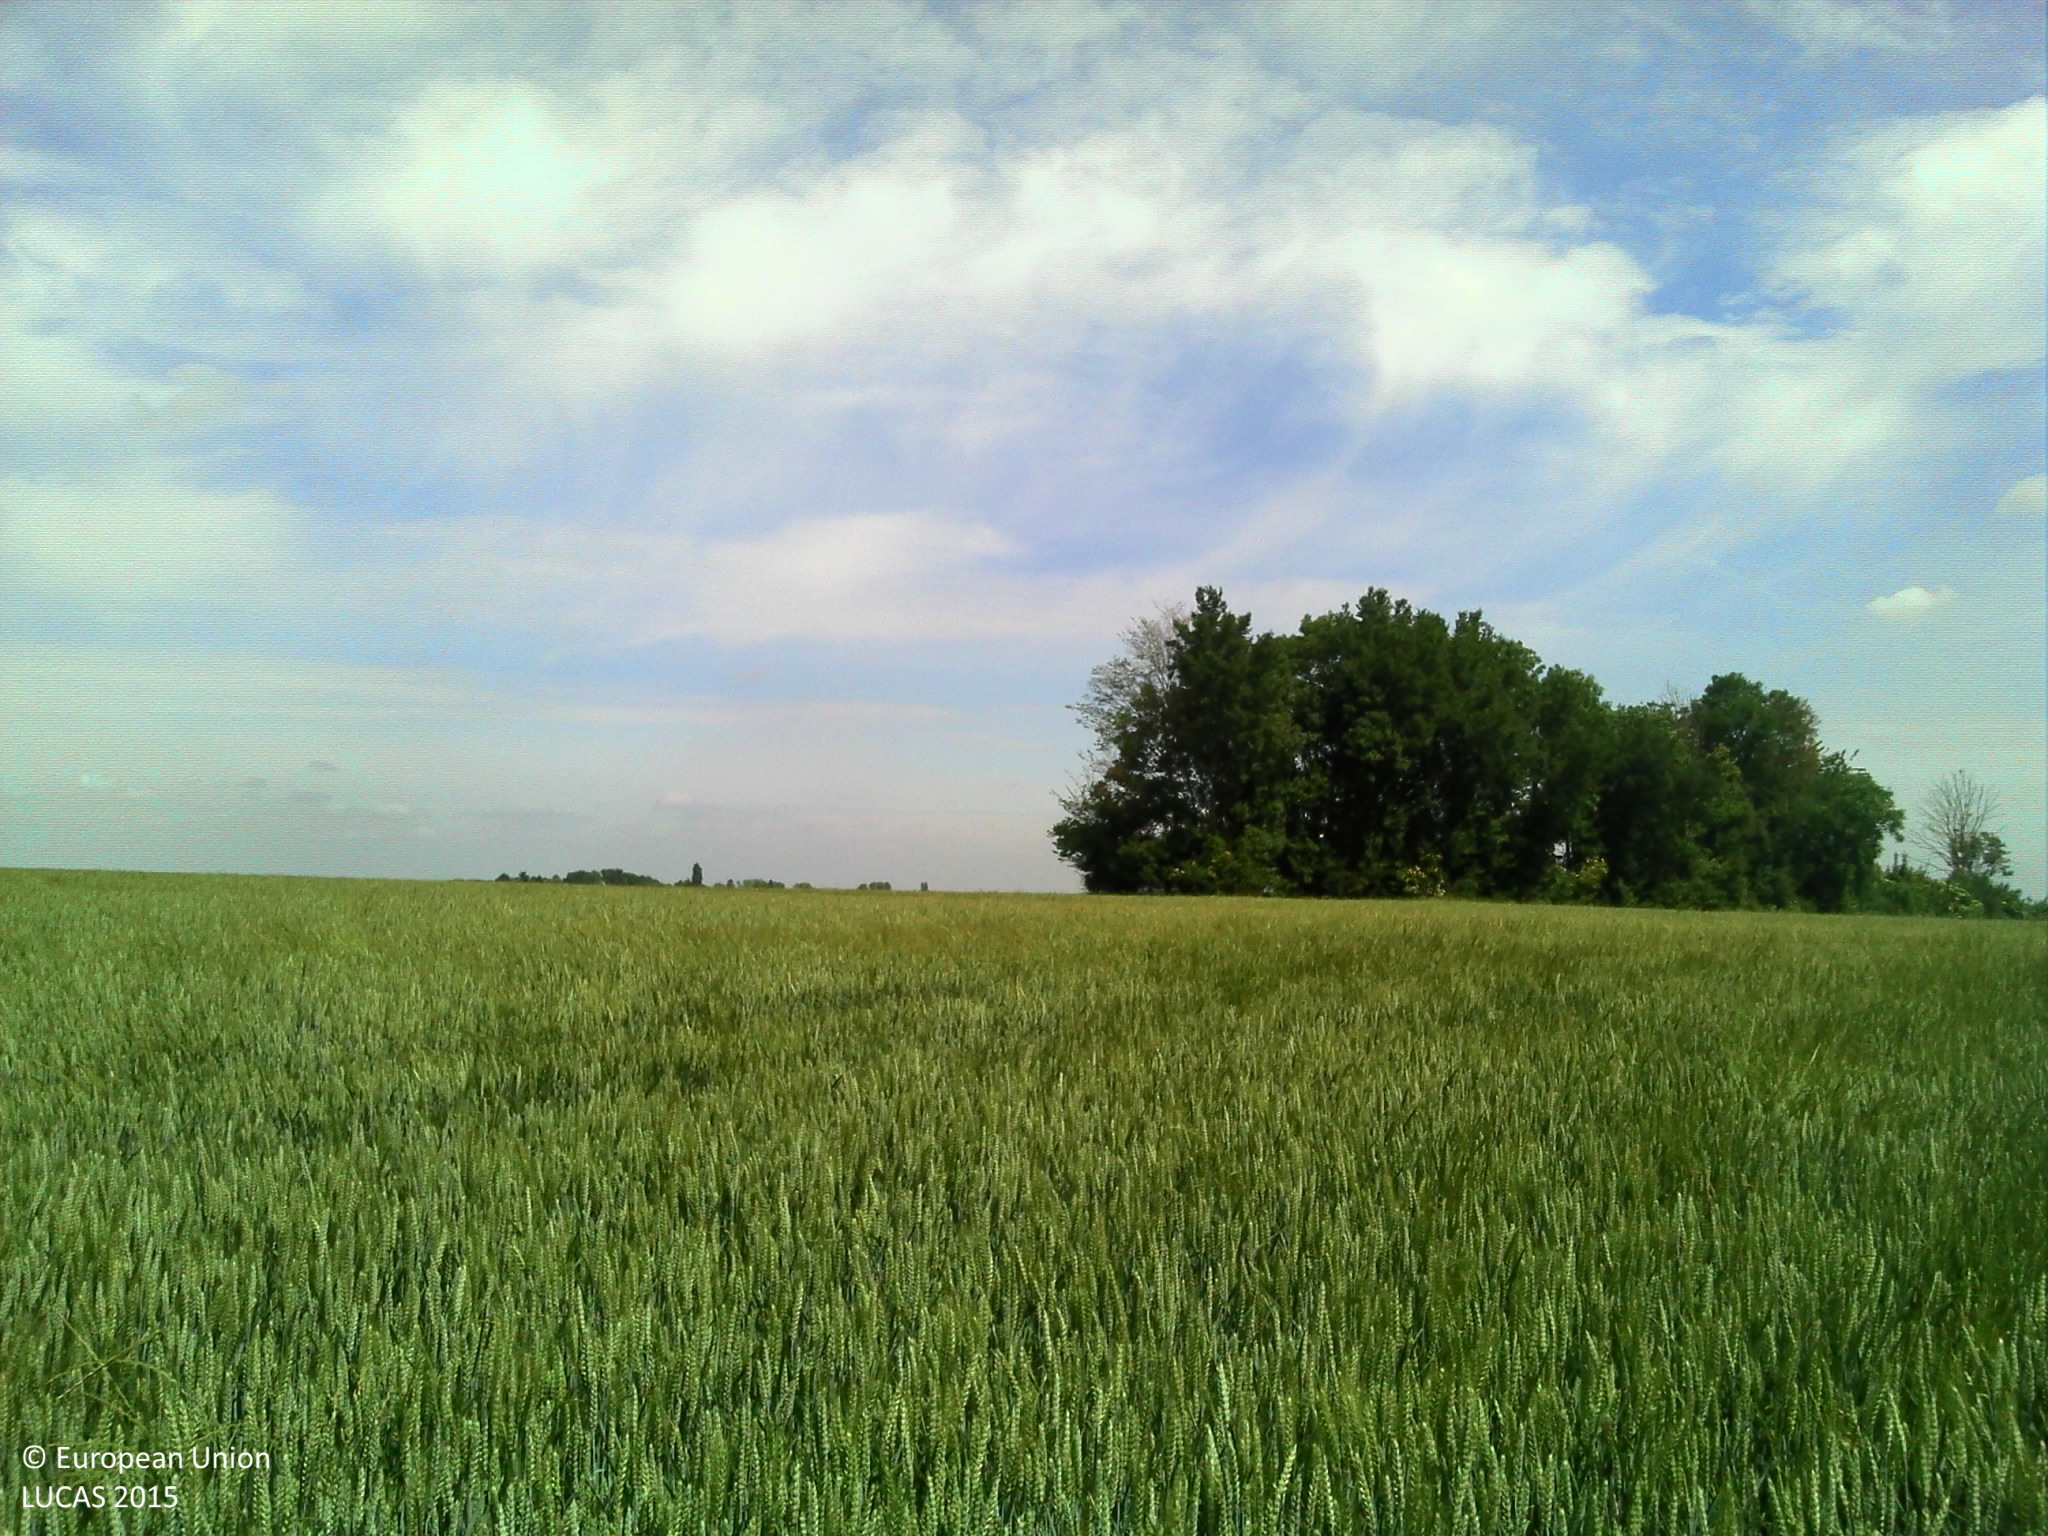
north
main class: Cropland
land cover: Common wheat
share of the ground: > 75 %
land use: Agriculture (excluding fallow land and kitchen gardens)
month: June
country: FR
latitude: 49.5959
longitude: 2.5309
